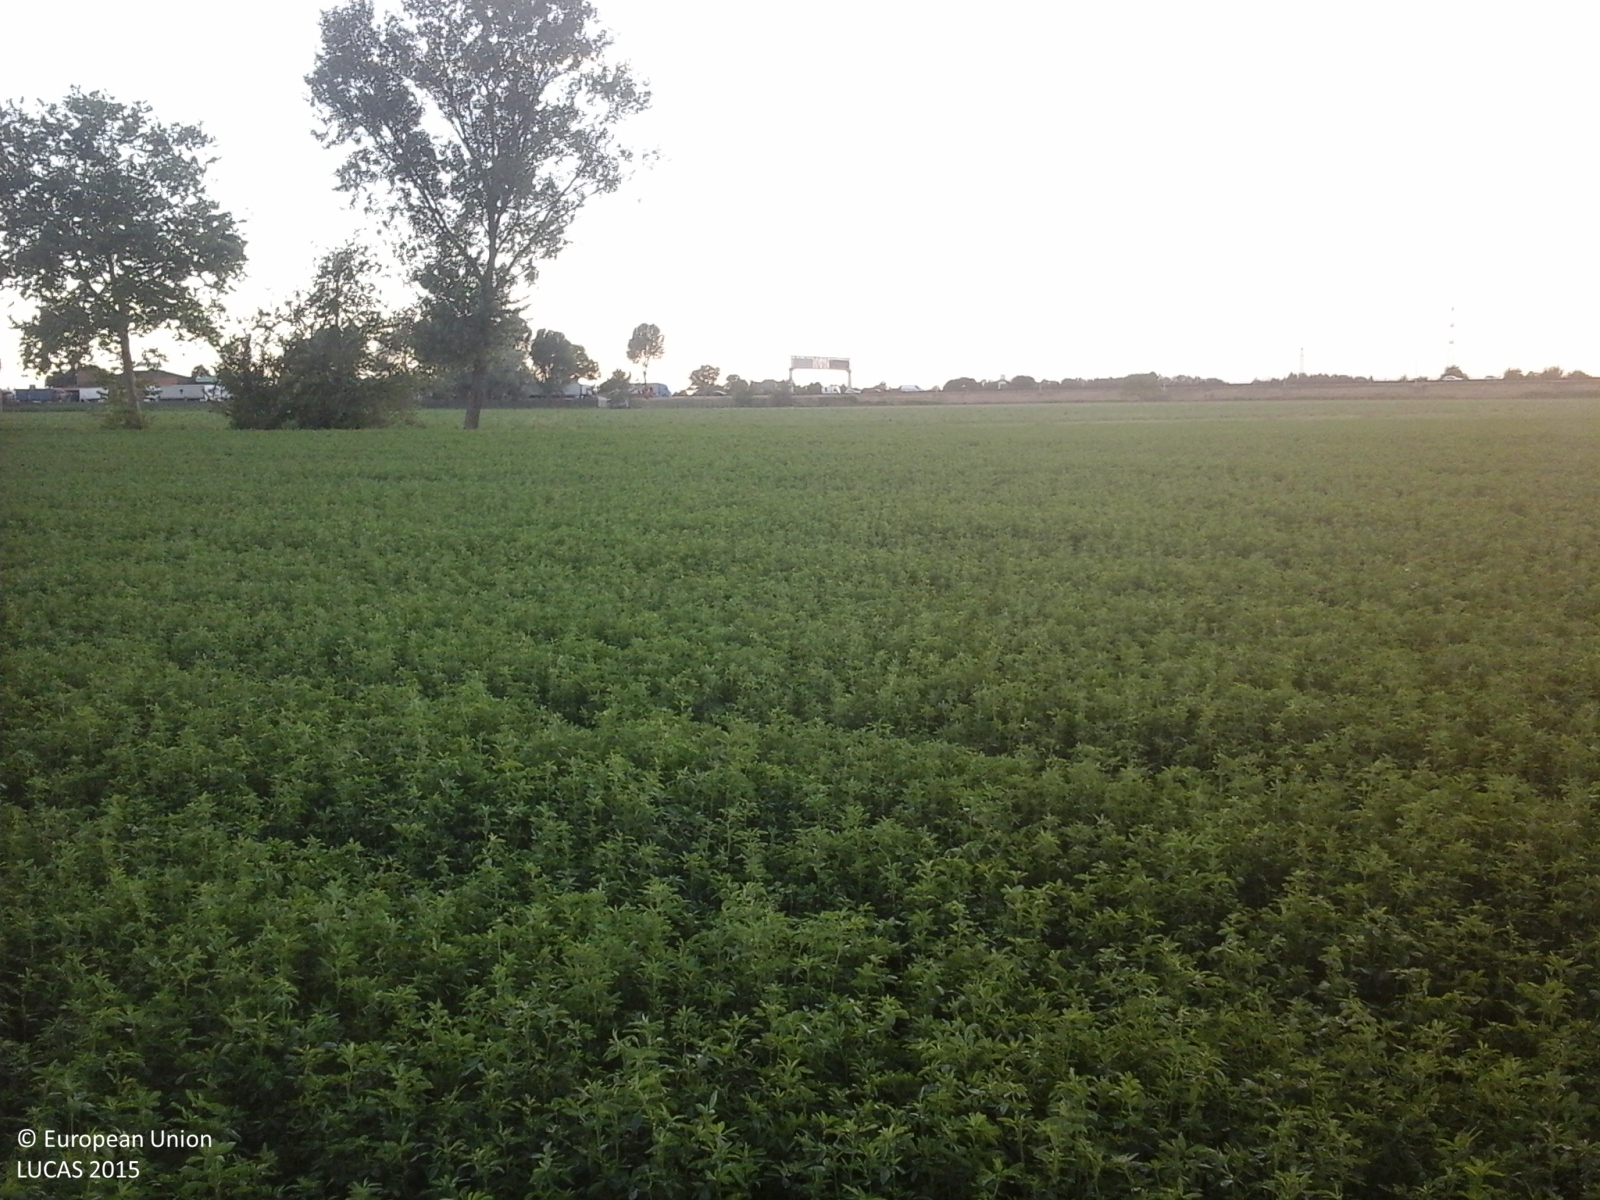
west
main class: Cropland
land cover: Lucerne
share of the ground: > 75 %
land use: Agriculture (excluding fallow land and kitchen gardens)
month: May
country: IT
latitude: 45.0684
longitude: 10.8493
